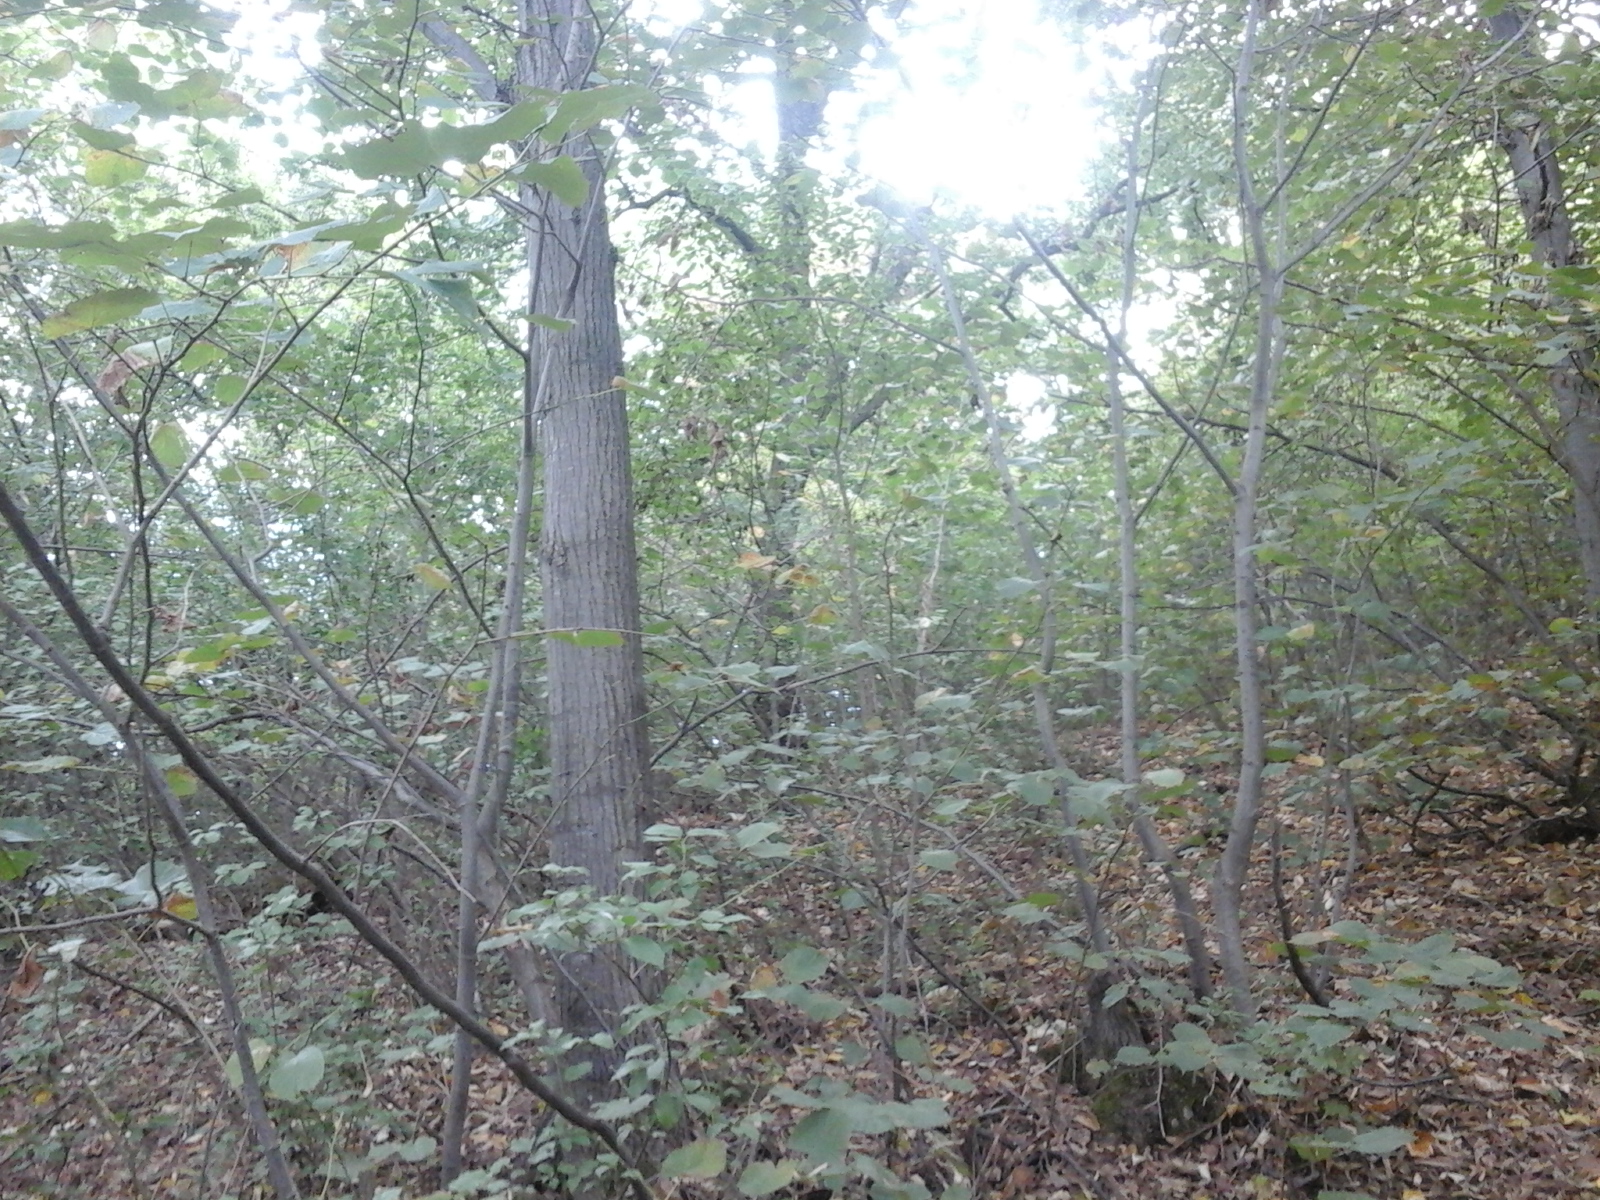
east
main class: Woodland
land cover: Broadleaved woodland
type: beech forest
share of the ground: > 75 %
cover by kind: broadleaved forest trees 100 %
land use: Forestry
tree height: > 5 m
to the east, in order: Broadleaved woodland; Vineyards
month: August
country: RO
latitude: 46.2758
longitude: 21.6530
